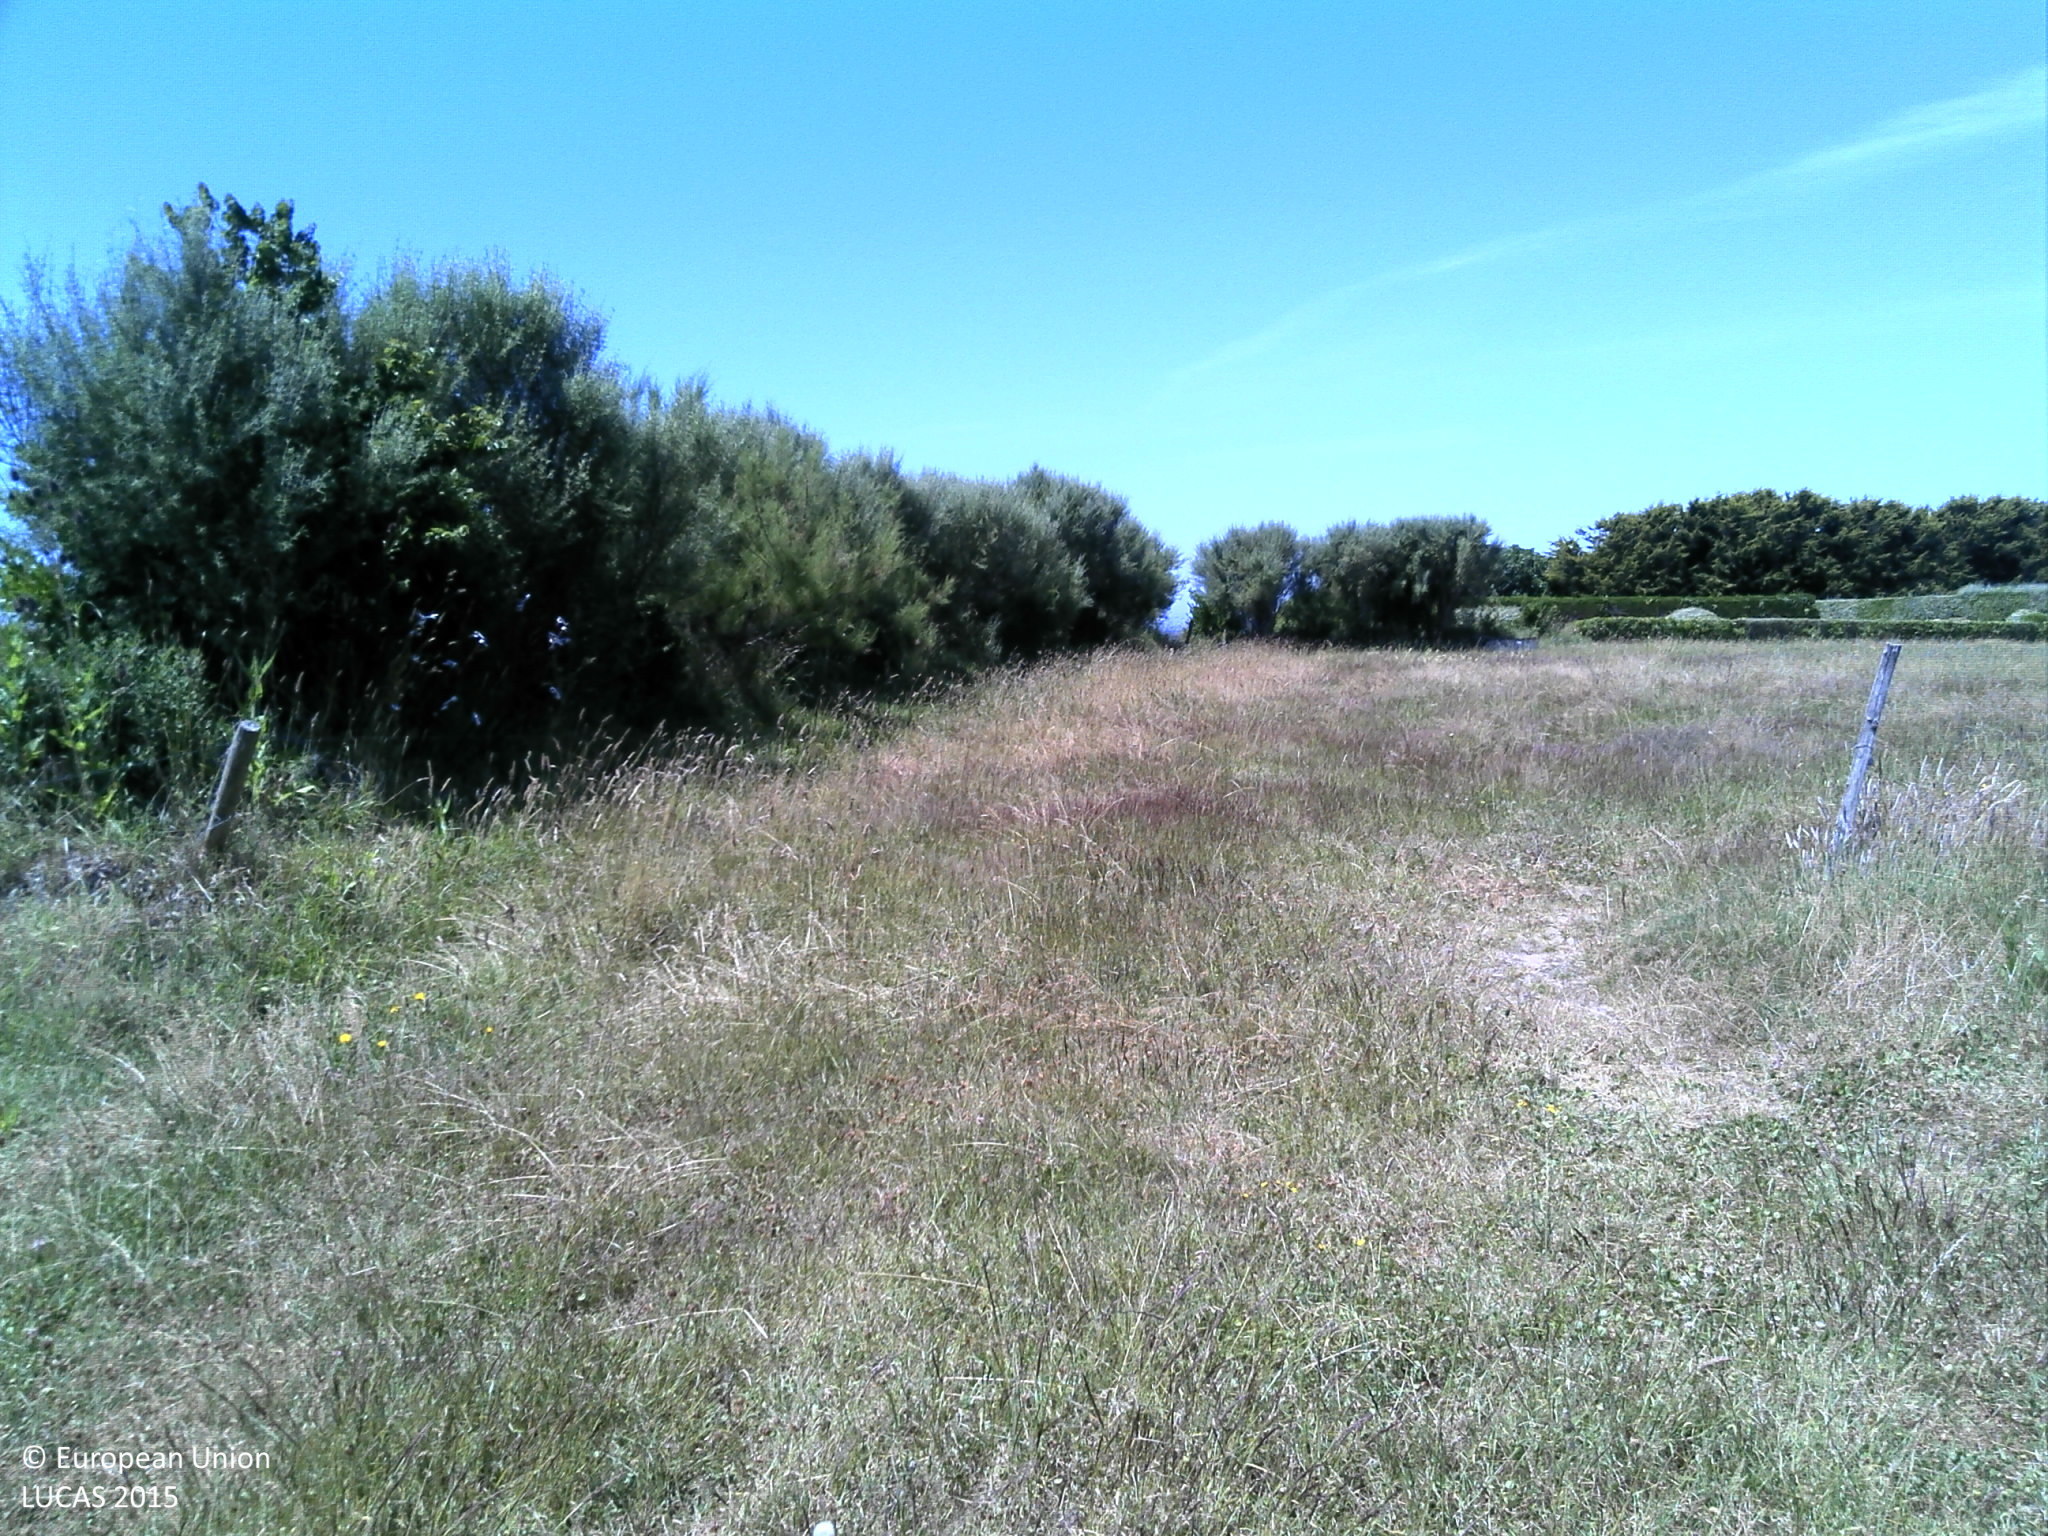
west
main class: Grassland
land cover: Grassland without tree/shrub cover
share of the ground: > 75 %
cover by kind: herbaceous plants 100 %
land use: Agriculture (excluding fallow land and kitchen gardens)
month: June
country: FR
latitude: 47.8836
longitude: -4.3342
